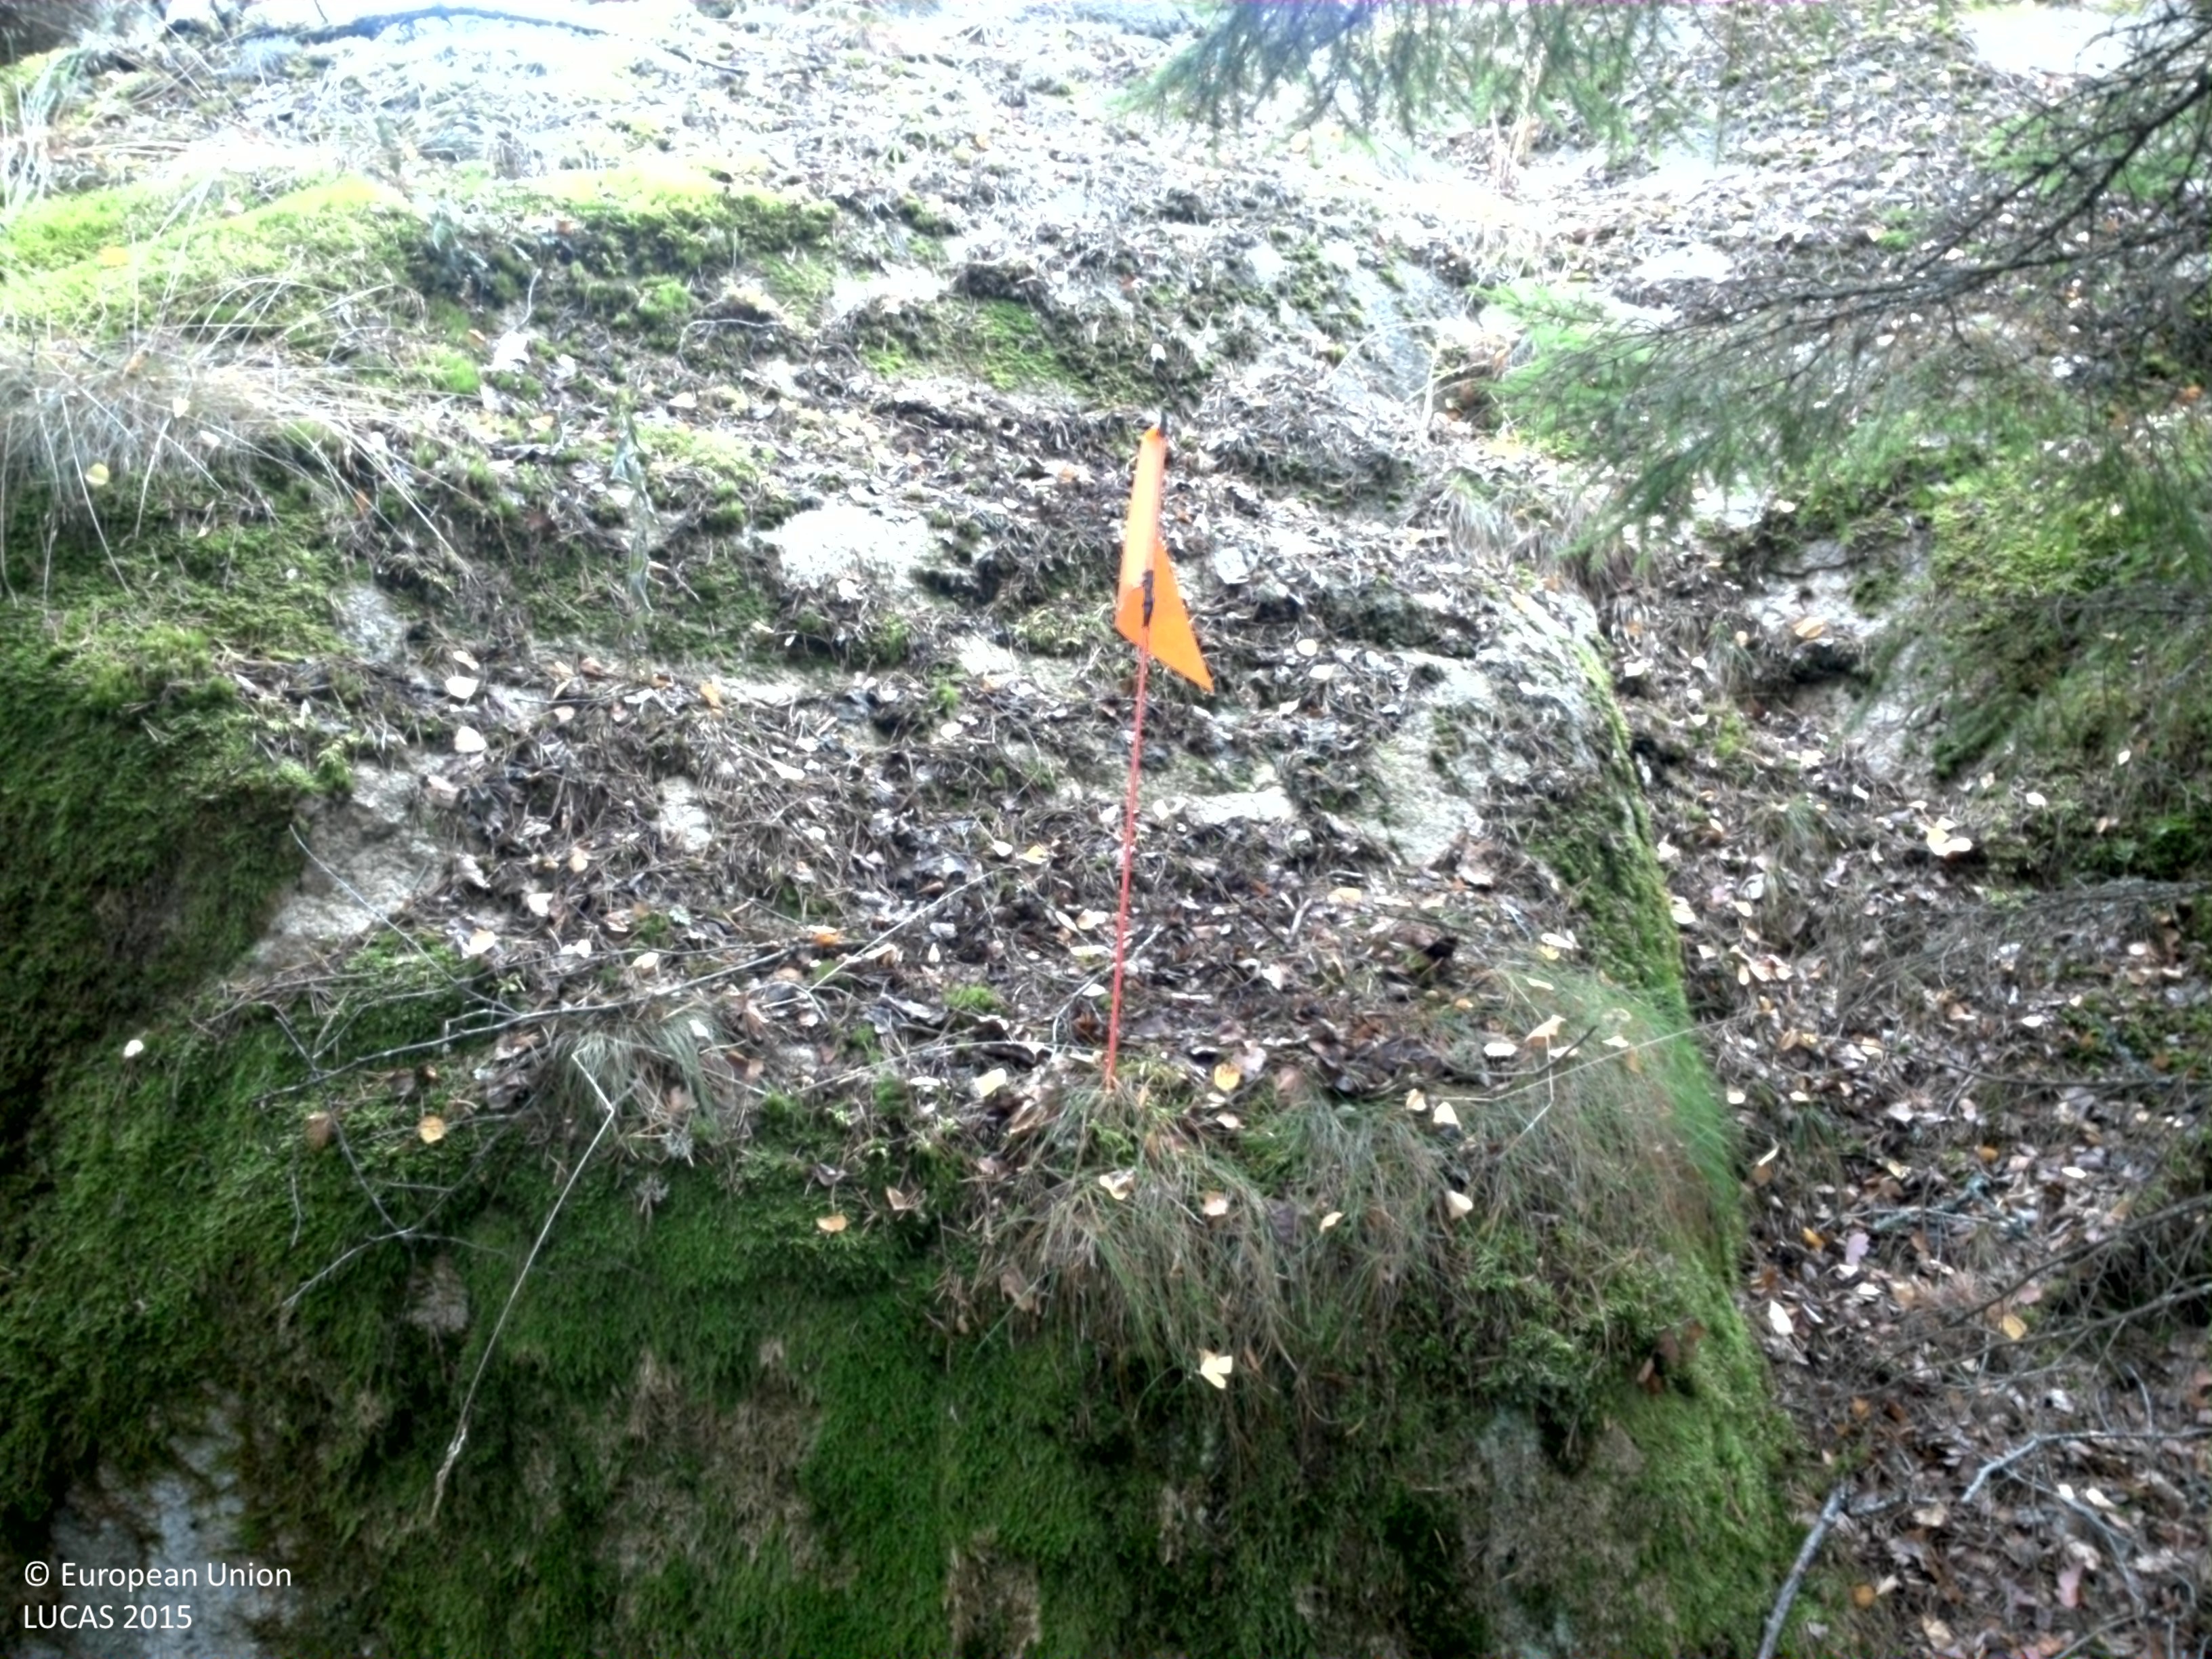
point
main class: Woodland
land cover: Pine dominated coniferous woodland
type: boreal forest
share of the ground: > 75 %
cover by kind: coniferous forest trees 75 %, herbaceous plants 10 %, lichens and mosses 10 %, broadleaved forest trees 5 %
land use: Forestry
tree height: > 5 m
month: August
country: SE
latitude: 59.9118
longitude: 17.7736
